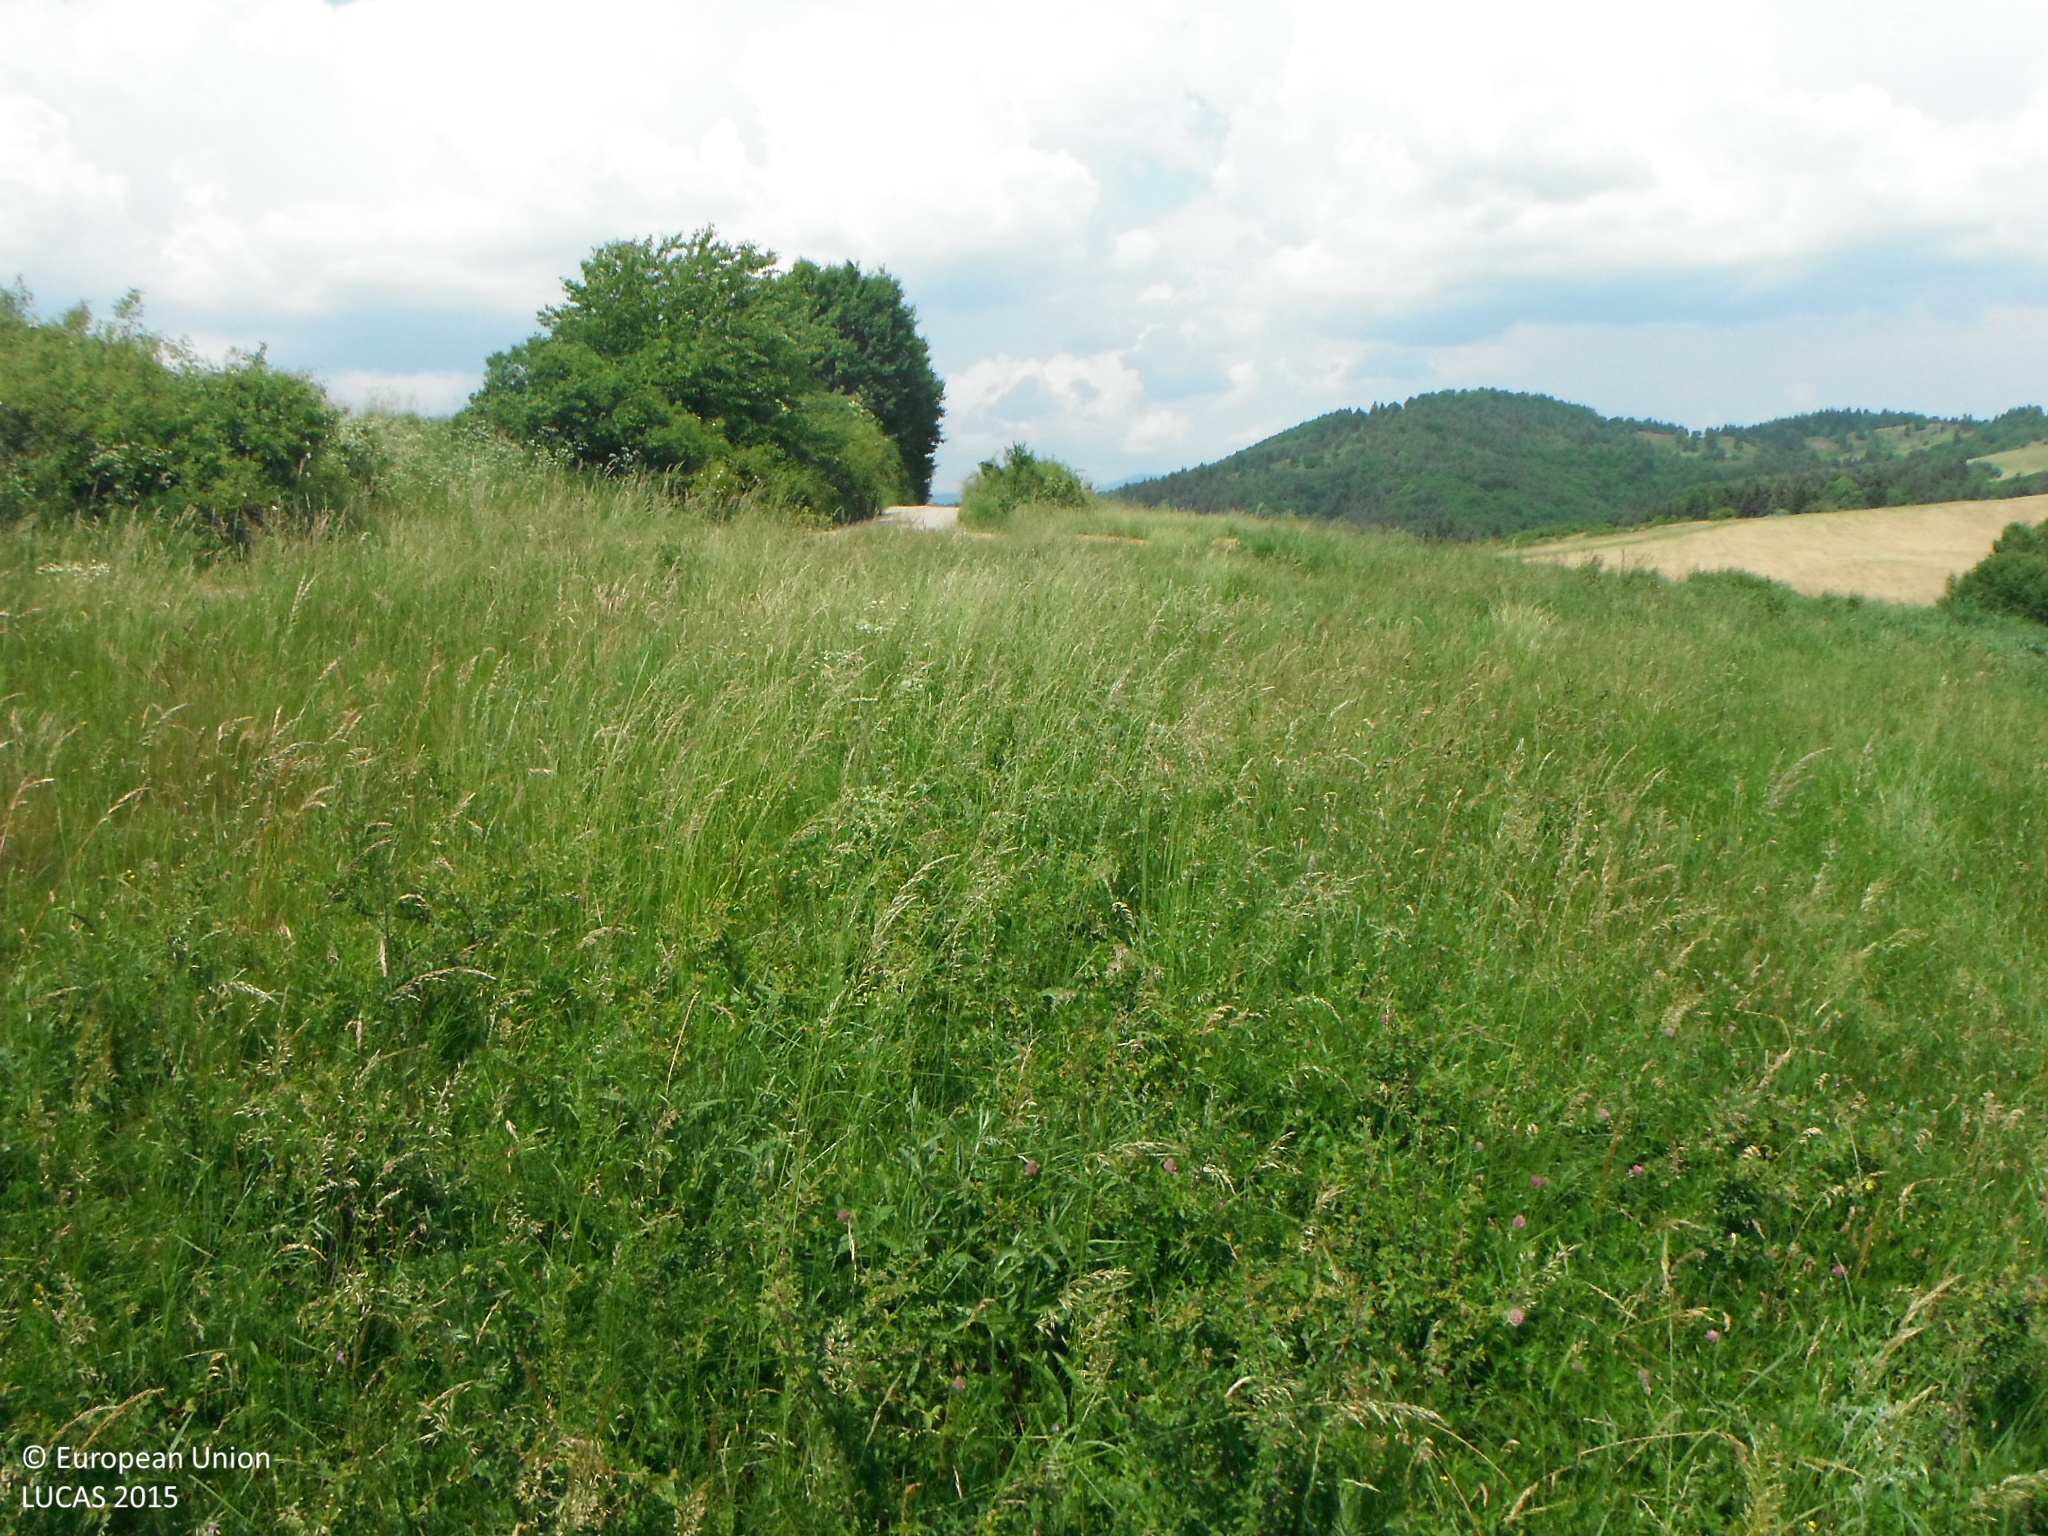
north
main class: Grassland
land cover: Grassland without tree/shrub cover
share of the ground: > 75 %
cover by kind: herbaceous plants 100 %
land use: Agriculture (excluding fallow land and kitchen gardens)
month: June
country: SK
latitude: 48.7188
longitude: 19.2798
